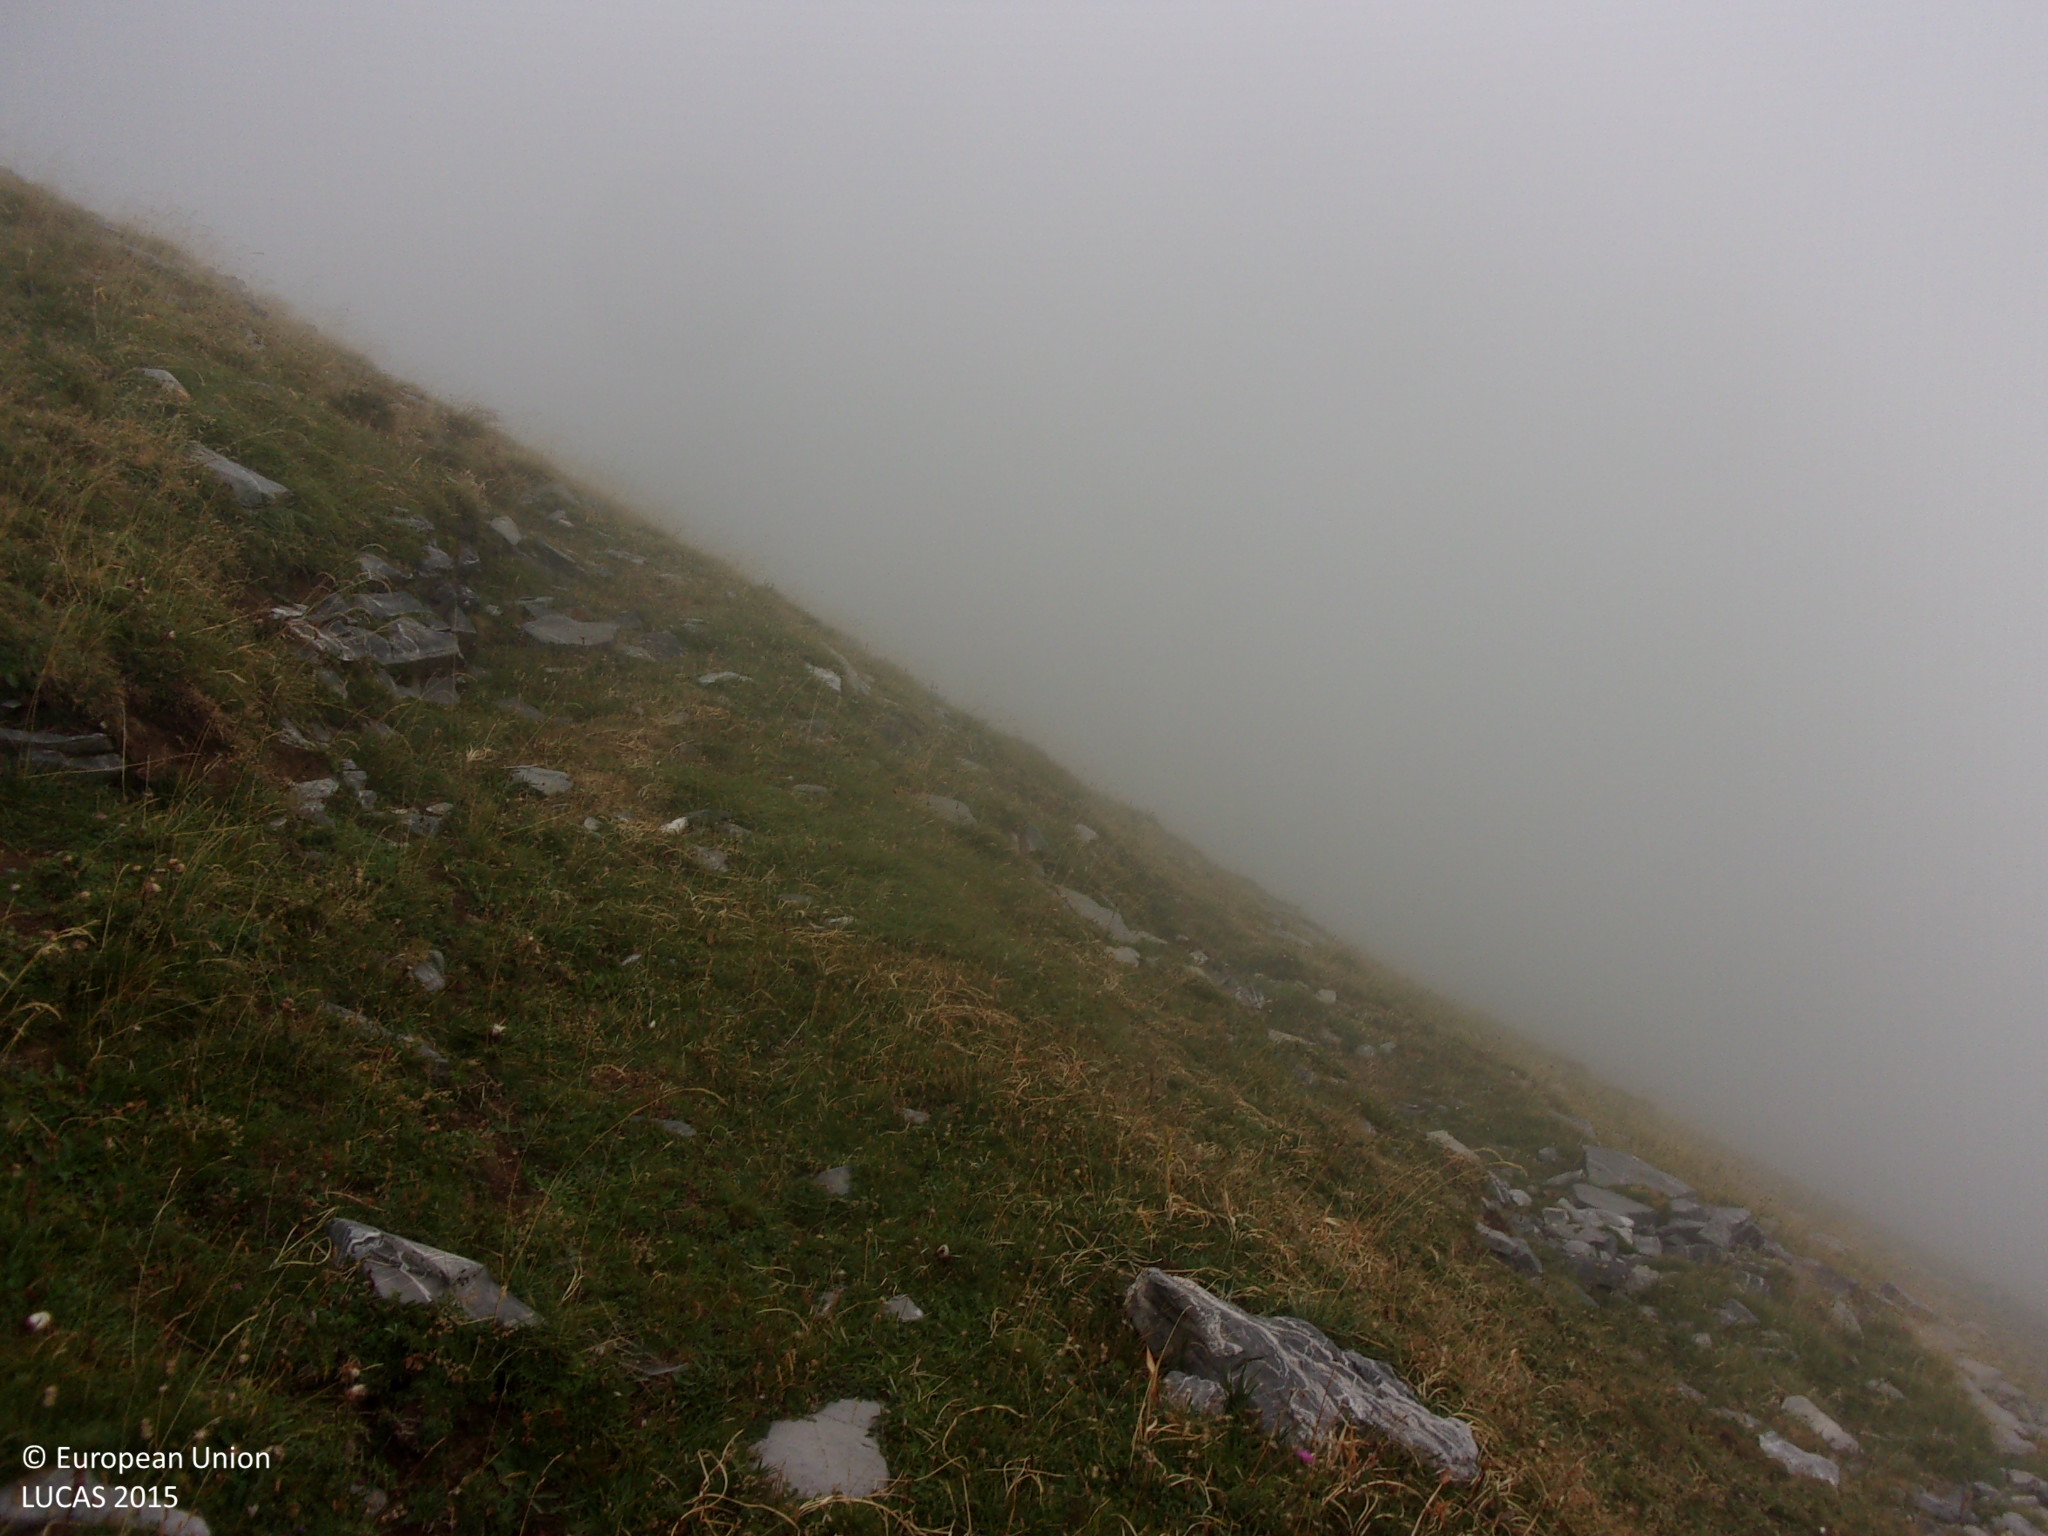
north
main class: Grassland
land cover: Grassland without tree/shrub cover
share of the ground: > 75 %
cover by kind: herbaceous plants 80 %, consolidated bare surface 20 %
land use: Semi-natural and natural areas not in use
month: August
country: ES
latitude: 42.7771
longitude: -0.5279
